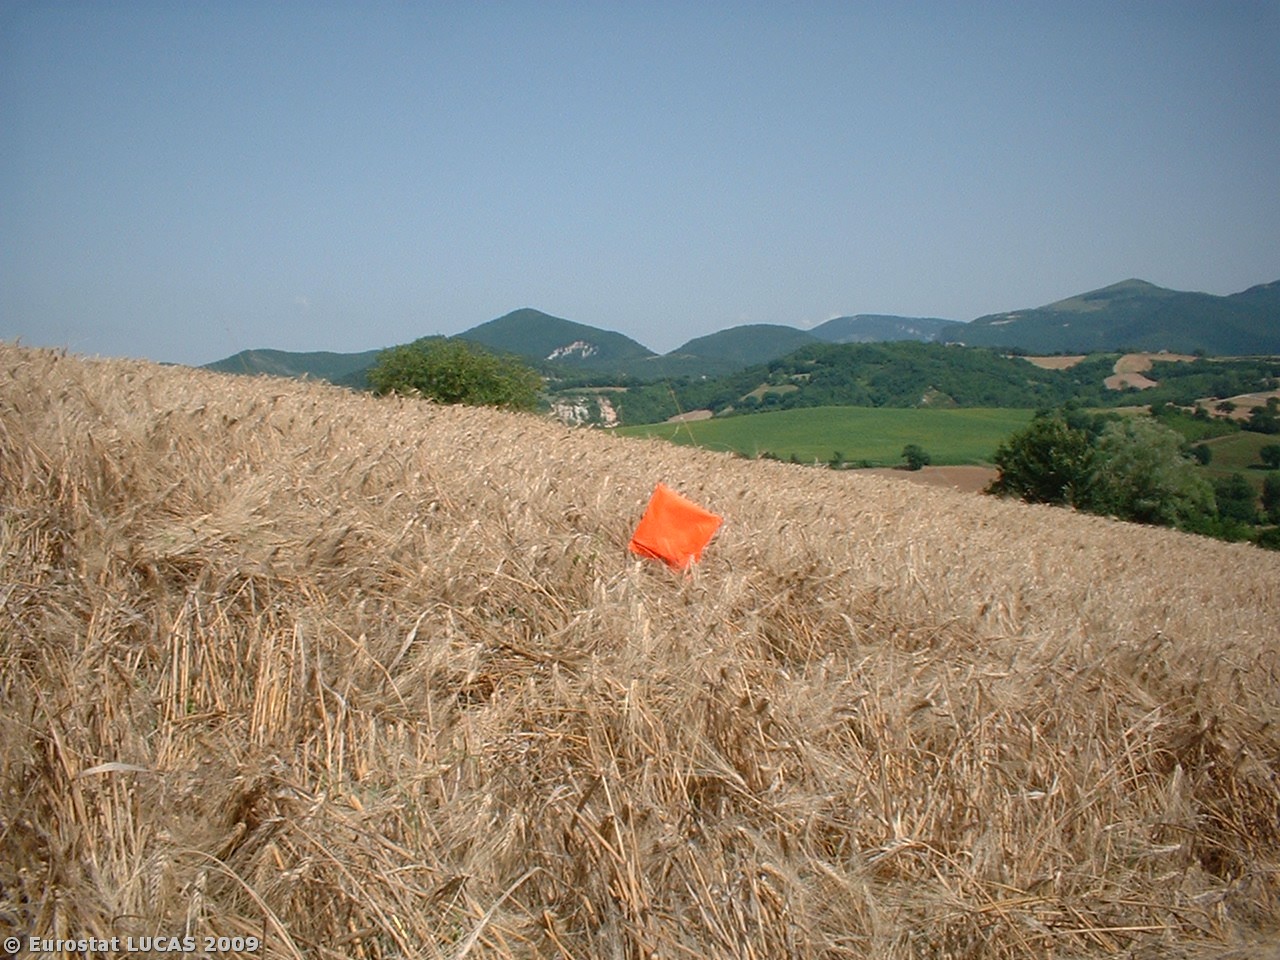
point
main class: Cropland
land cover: Durum wheat
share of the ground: > 75 %
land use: Agriculture (excluding fallow land and kitchen gardens)
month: July
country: IT
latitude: 43.4256
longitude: 12.8953
